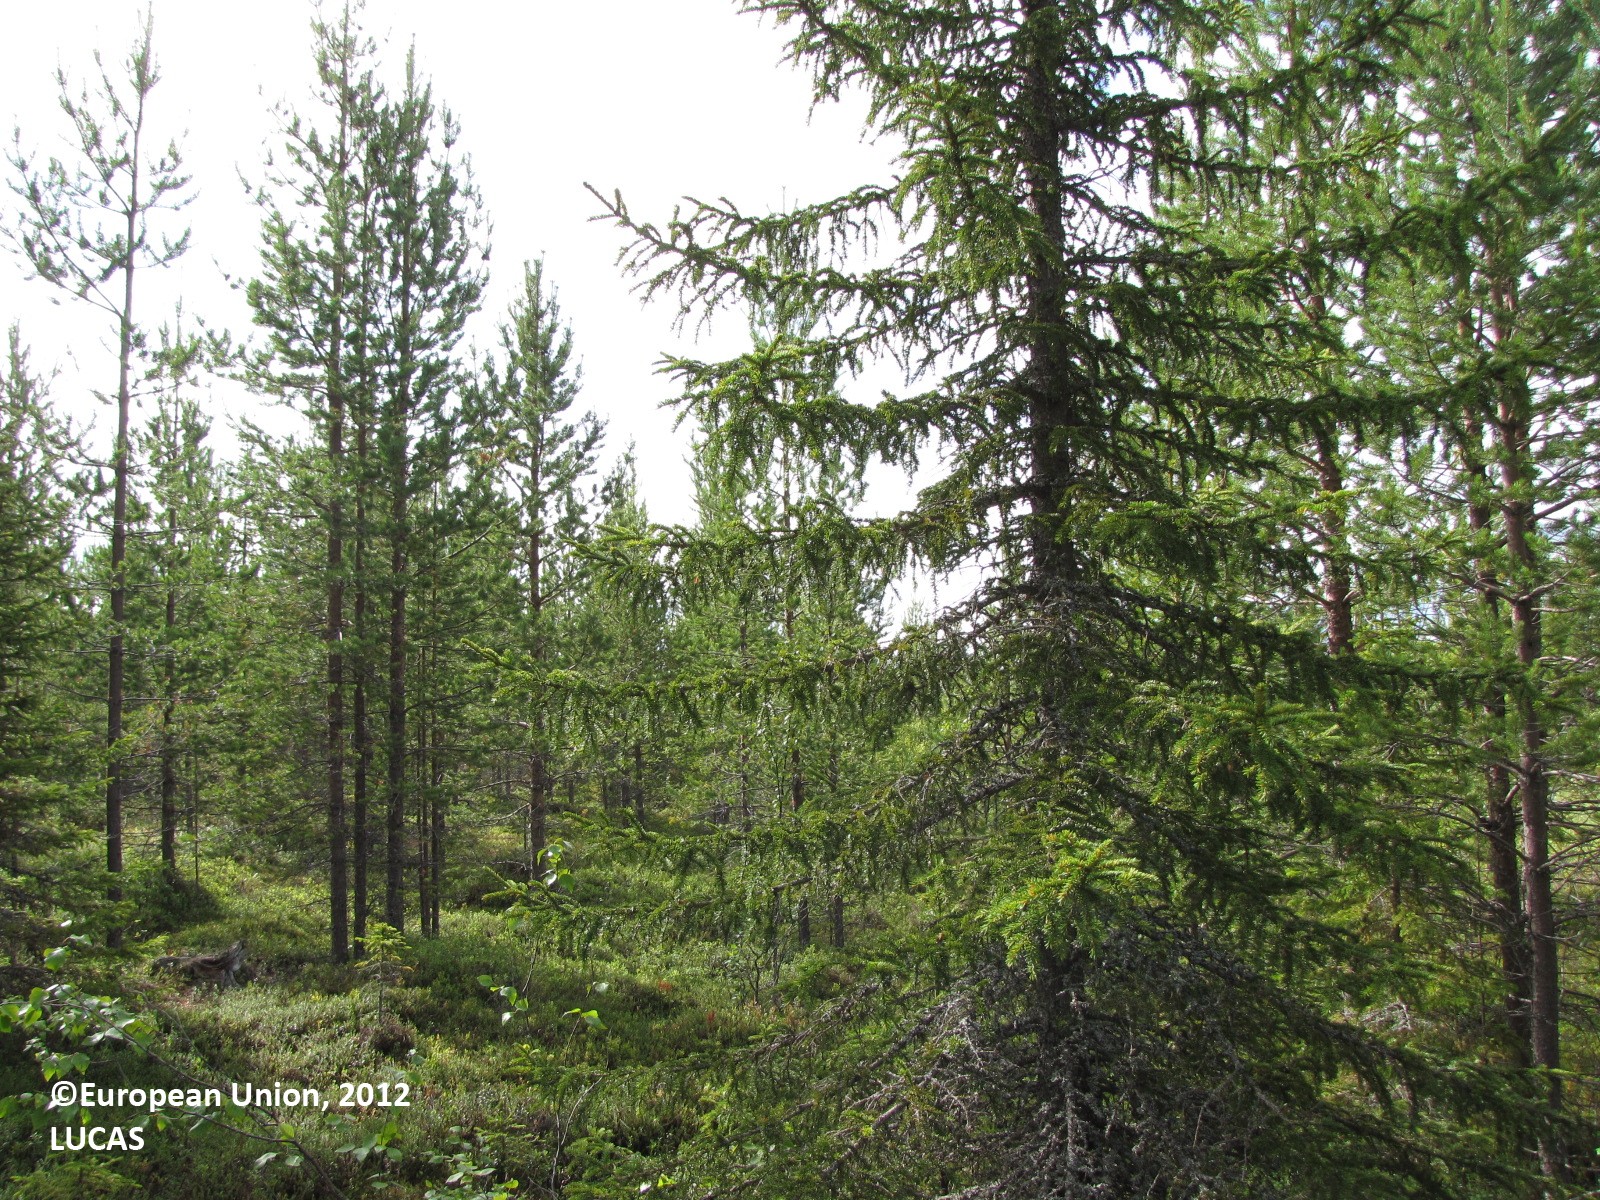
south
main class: Woodland
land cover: Pine dominated coniferous woodland
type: boreal forest
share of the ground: 25 - 50 %
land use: Forestry
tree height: > 5 m
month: August
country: FI
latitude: 66.8913
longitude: 24.6317
